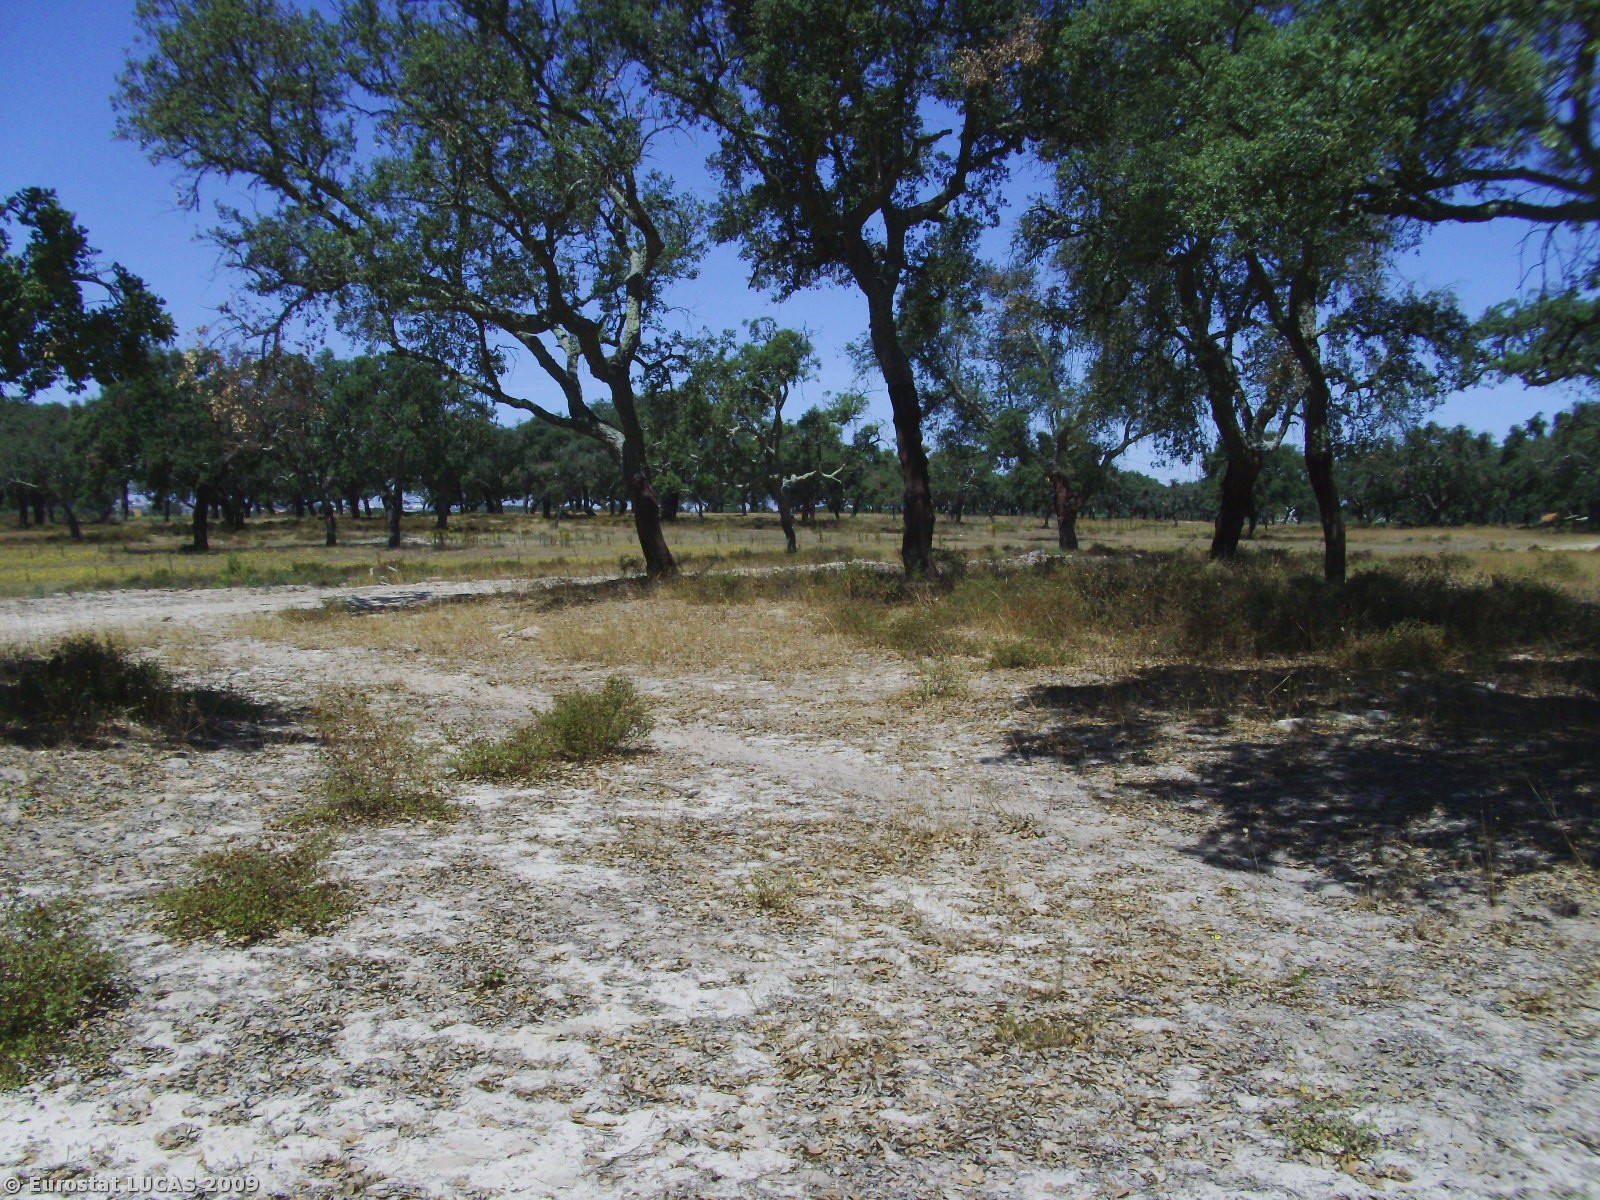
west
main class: Woodland
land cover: Broadleaved woodland
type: broadleaved evergreen forest
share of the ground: 10 - 25 %
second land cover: Spontaneously vegetated surfaces
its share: 50 - 75 %
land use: Forestry
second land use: Fallow land
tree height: > 5 m
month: August
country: PT
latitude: 38.7311
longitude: -8.8757
